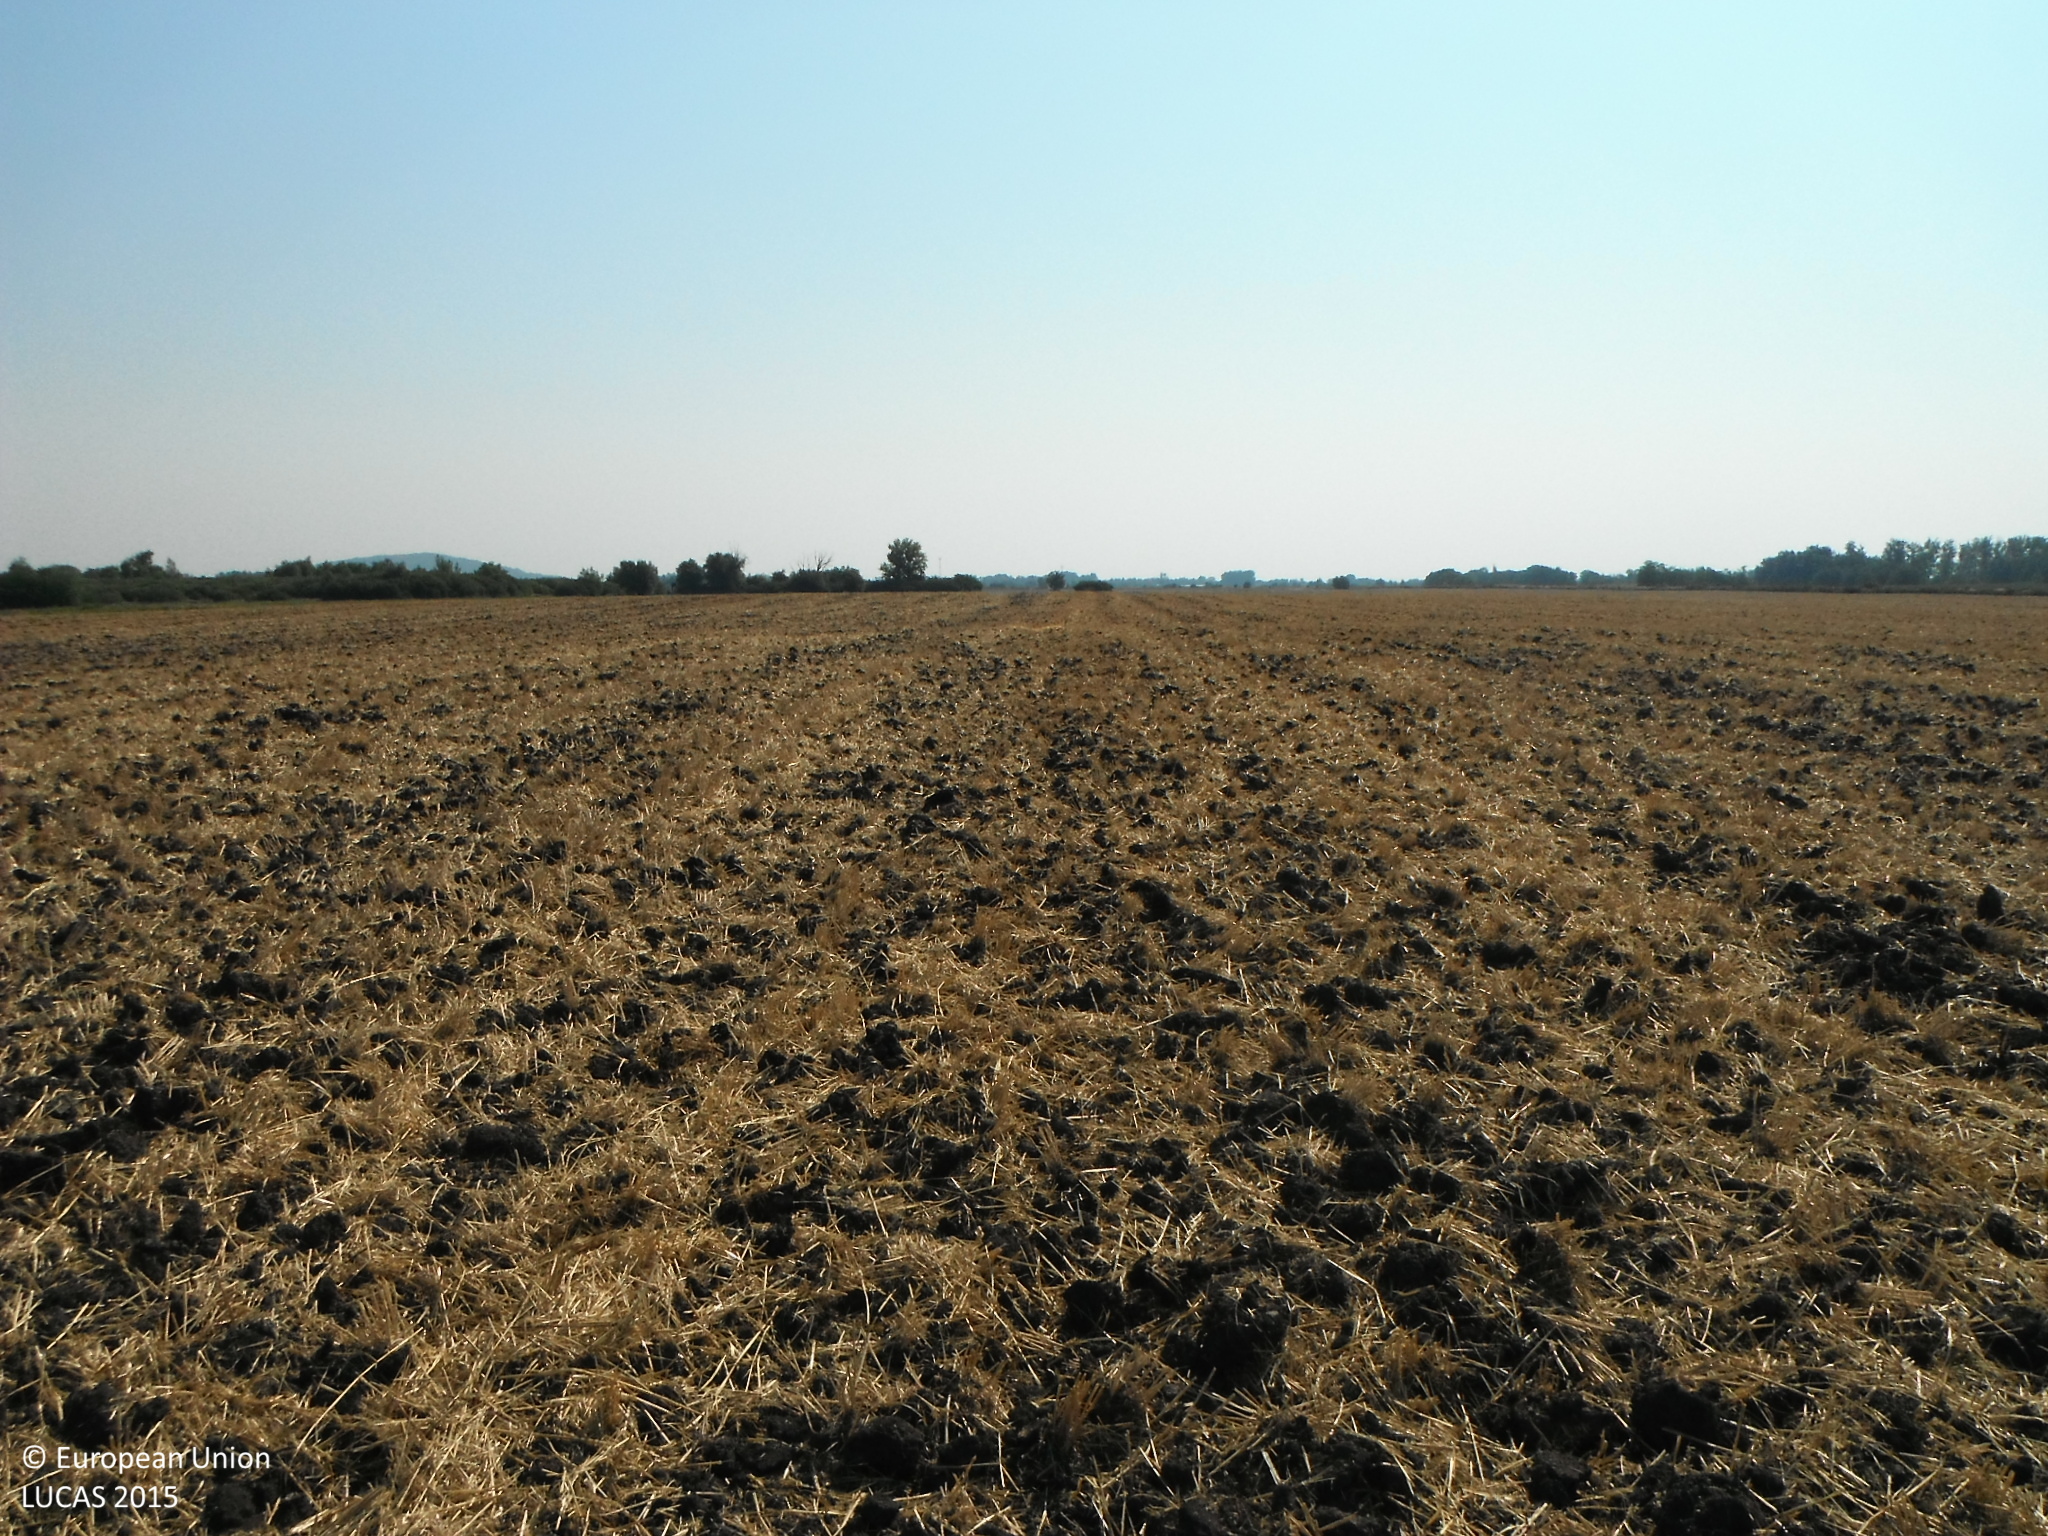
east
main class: Cropland
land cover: Common wheat
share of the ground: > 75 %
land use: Agriculture (excluding fallow land and kitchen gardens)
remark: Harvested field
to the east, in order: Common wheat
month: August
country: SK
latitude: 48.3980
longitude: 21.8701
